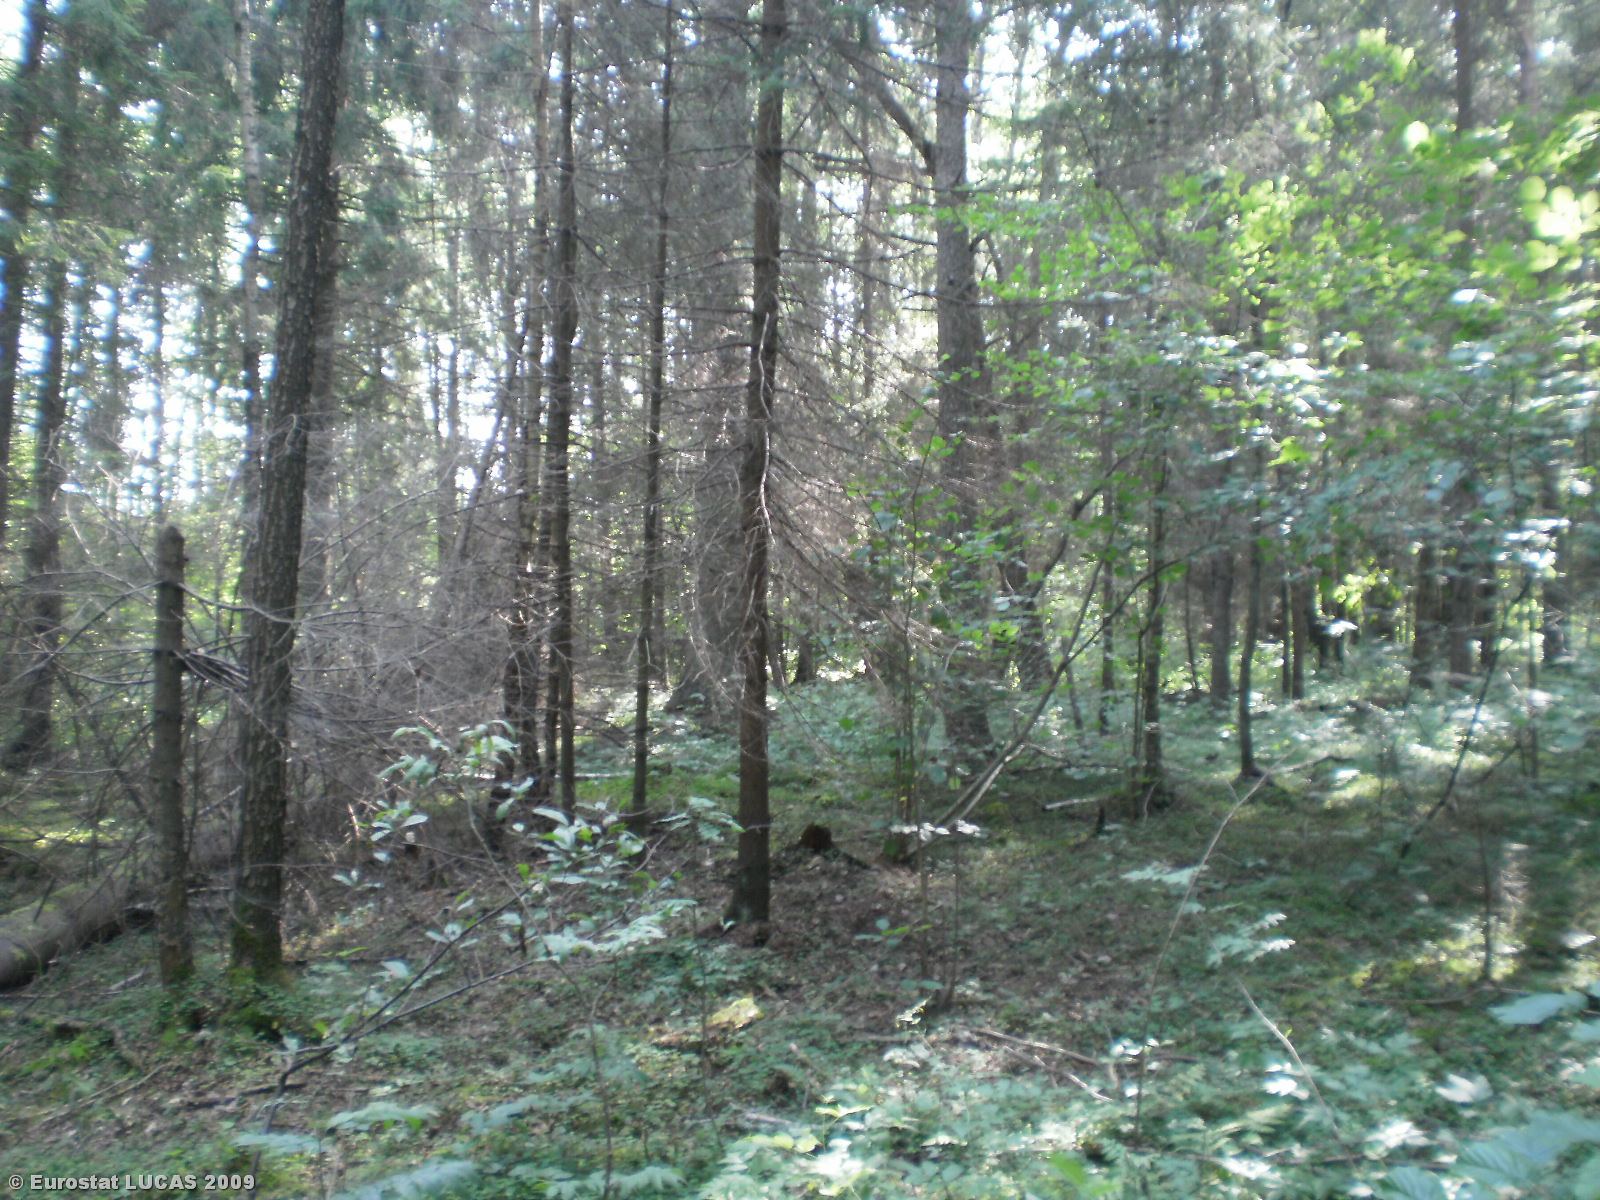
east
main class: Woodland
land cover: Coniferous woodland
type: hemiboreal forest and nemoral coniferous forest and mixed broadleaved-coniferous forest
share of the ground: > 75 %
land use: Forestry
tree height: > 5 m
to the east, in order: Coniferous woodland; Broadleaved woodland; Spontaneously vegetated surfaces; Rivers and streams; Broadleaved woodland; Spontaneously vegetated surfaces; Rivers and streams
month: July
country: LT
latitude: 55.8816
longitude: 25.7804
